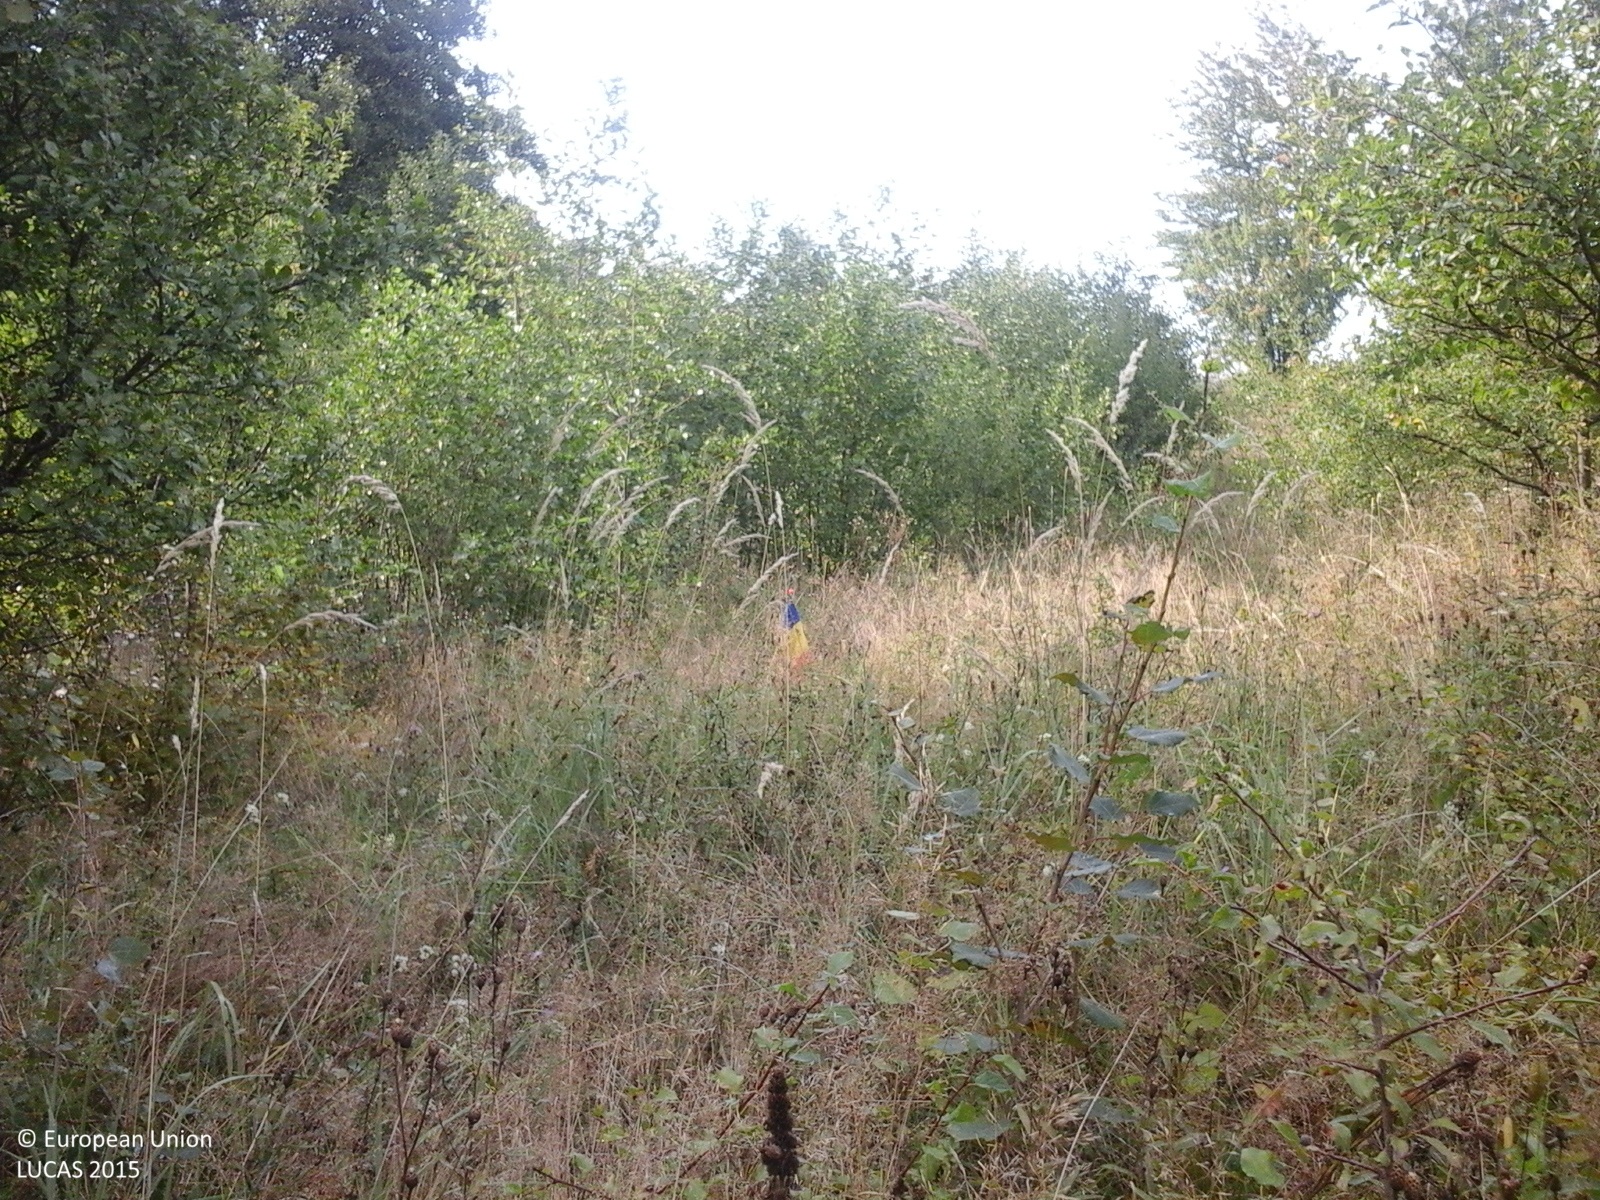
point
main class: Grassland
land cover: Grassland with sparse tree/shrub cover
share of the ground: > 75 %
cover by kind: herbaceous plants 85 %, shrubs 10 %, broadleaved forest trees 5 %
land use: Agriculture (excluding fallow land and kitchen gardens)
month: September
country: RO
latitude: 46.9296
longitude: 22.6250
